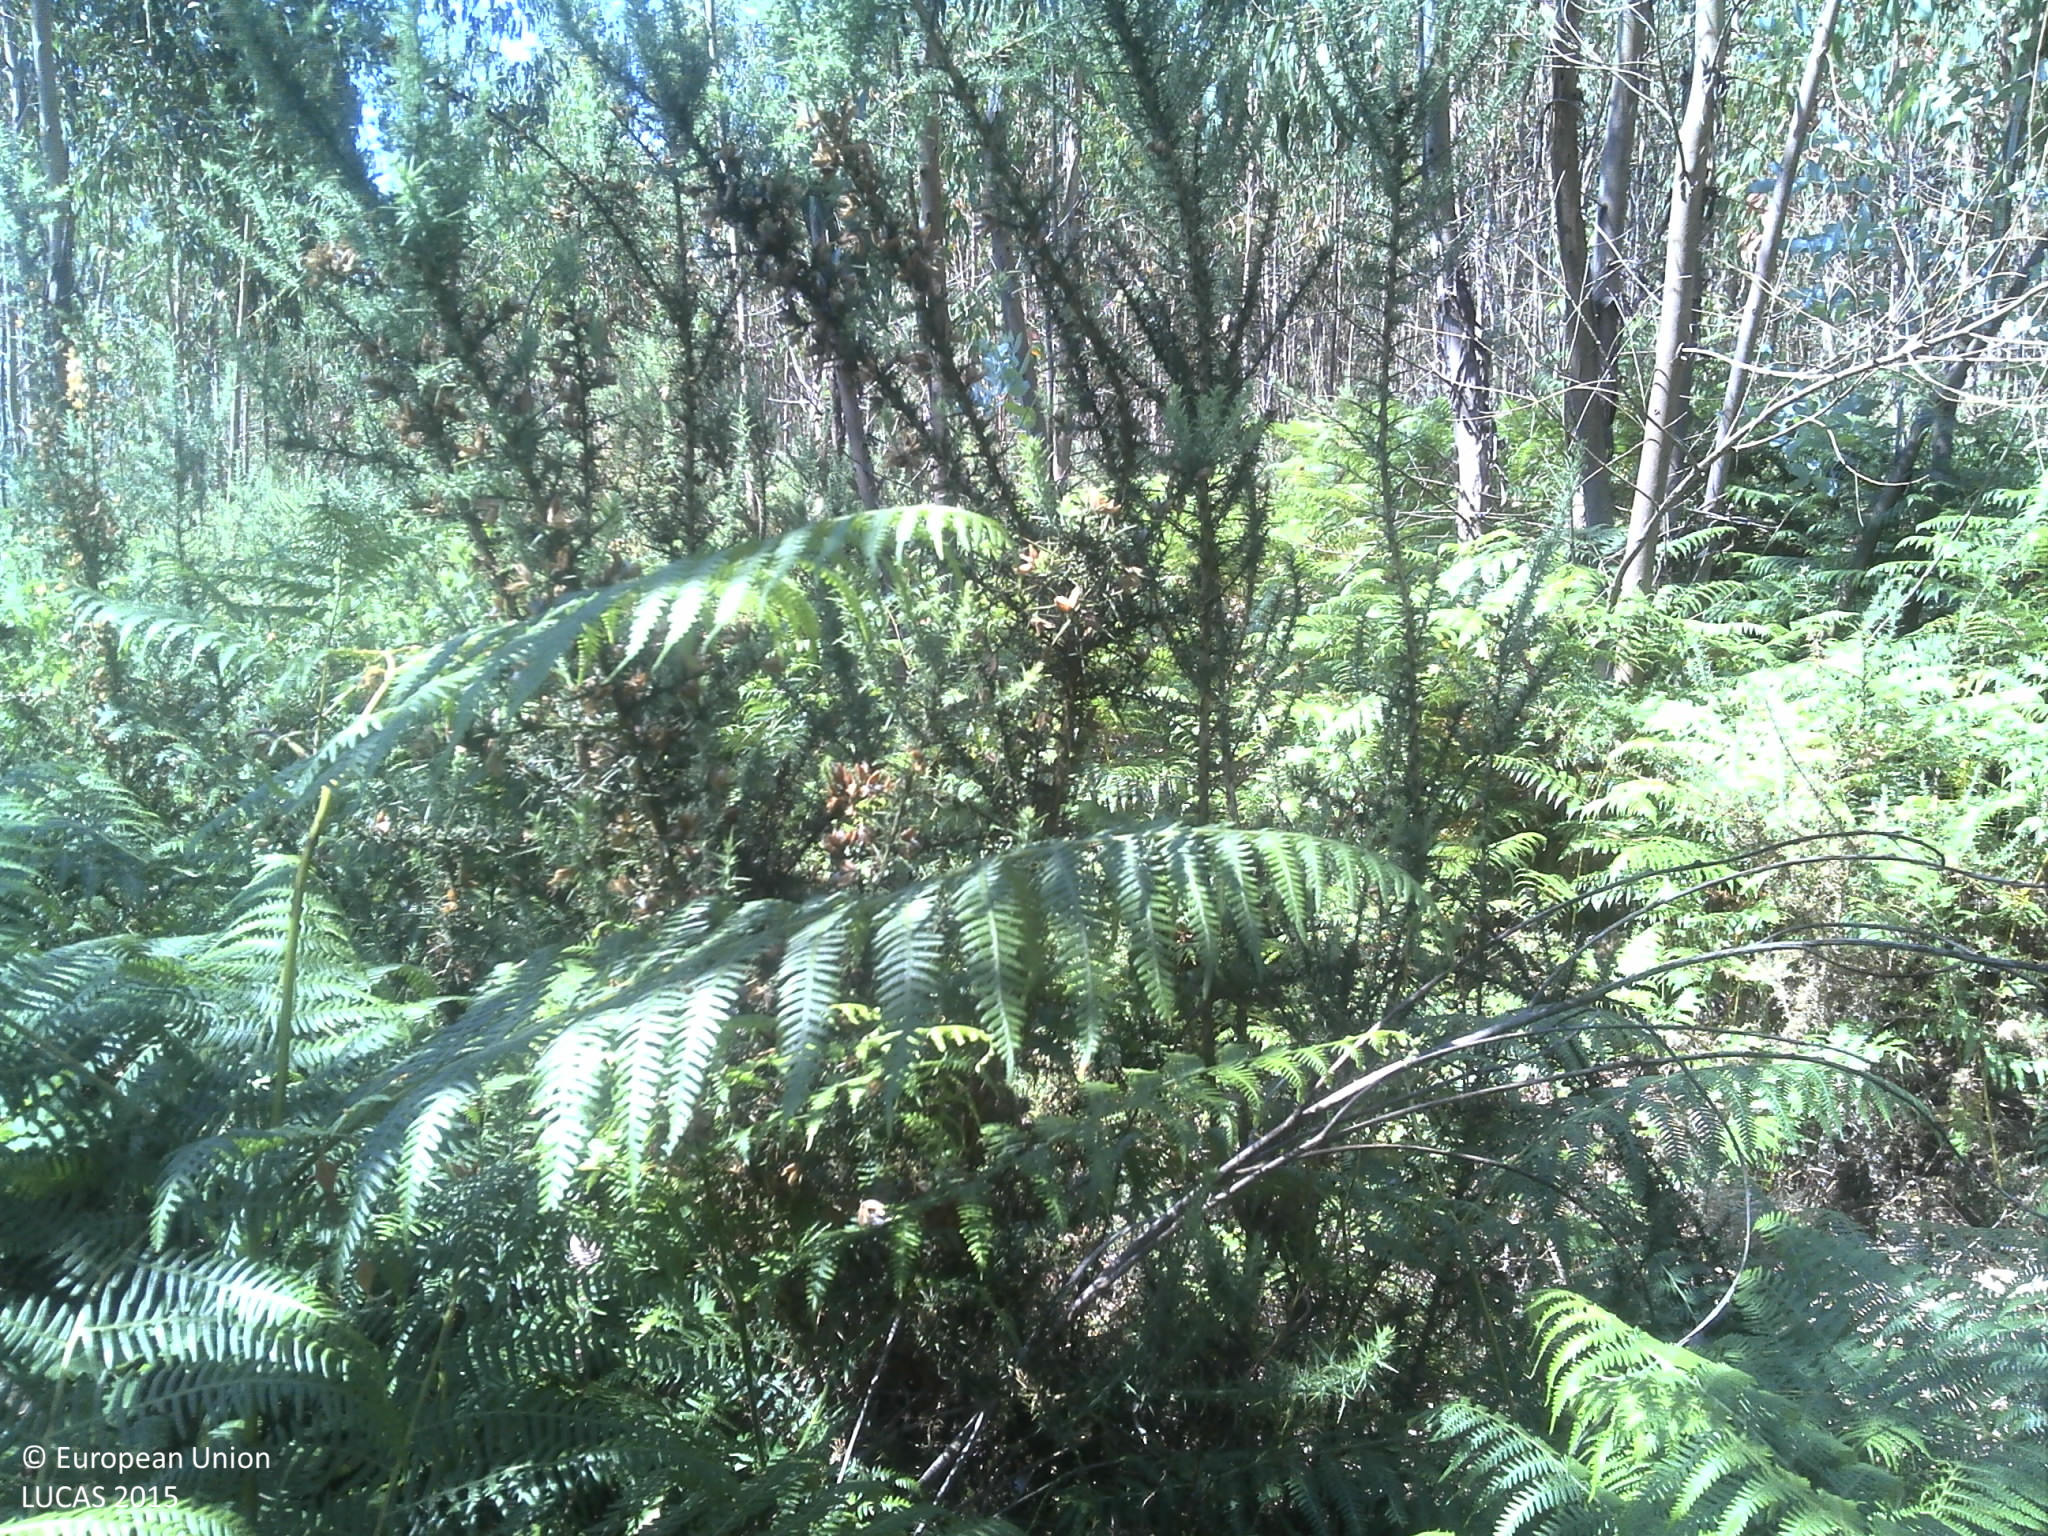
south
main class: Woodland
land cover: Broadleaved woodland
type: exotic forest
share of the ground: 25 - 50 %
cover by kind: broadleaved forest trees 50 %, shrubs 35 %, unconsolidated bare surface 10 %, herbaceous plants 5 %
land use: Forestry
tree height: > 5 m
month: June
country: PT
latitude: 41.3349
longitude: -8.1251
